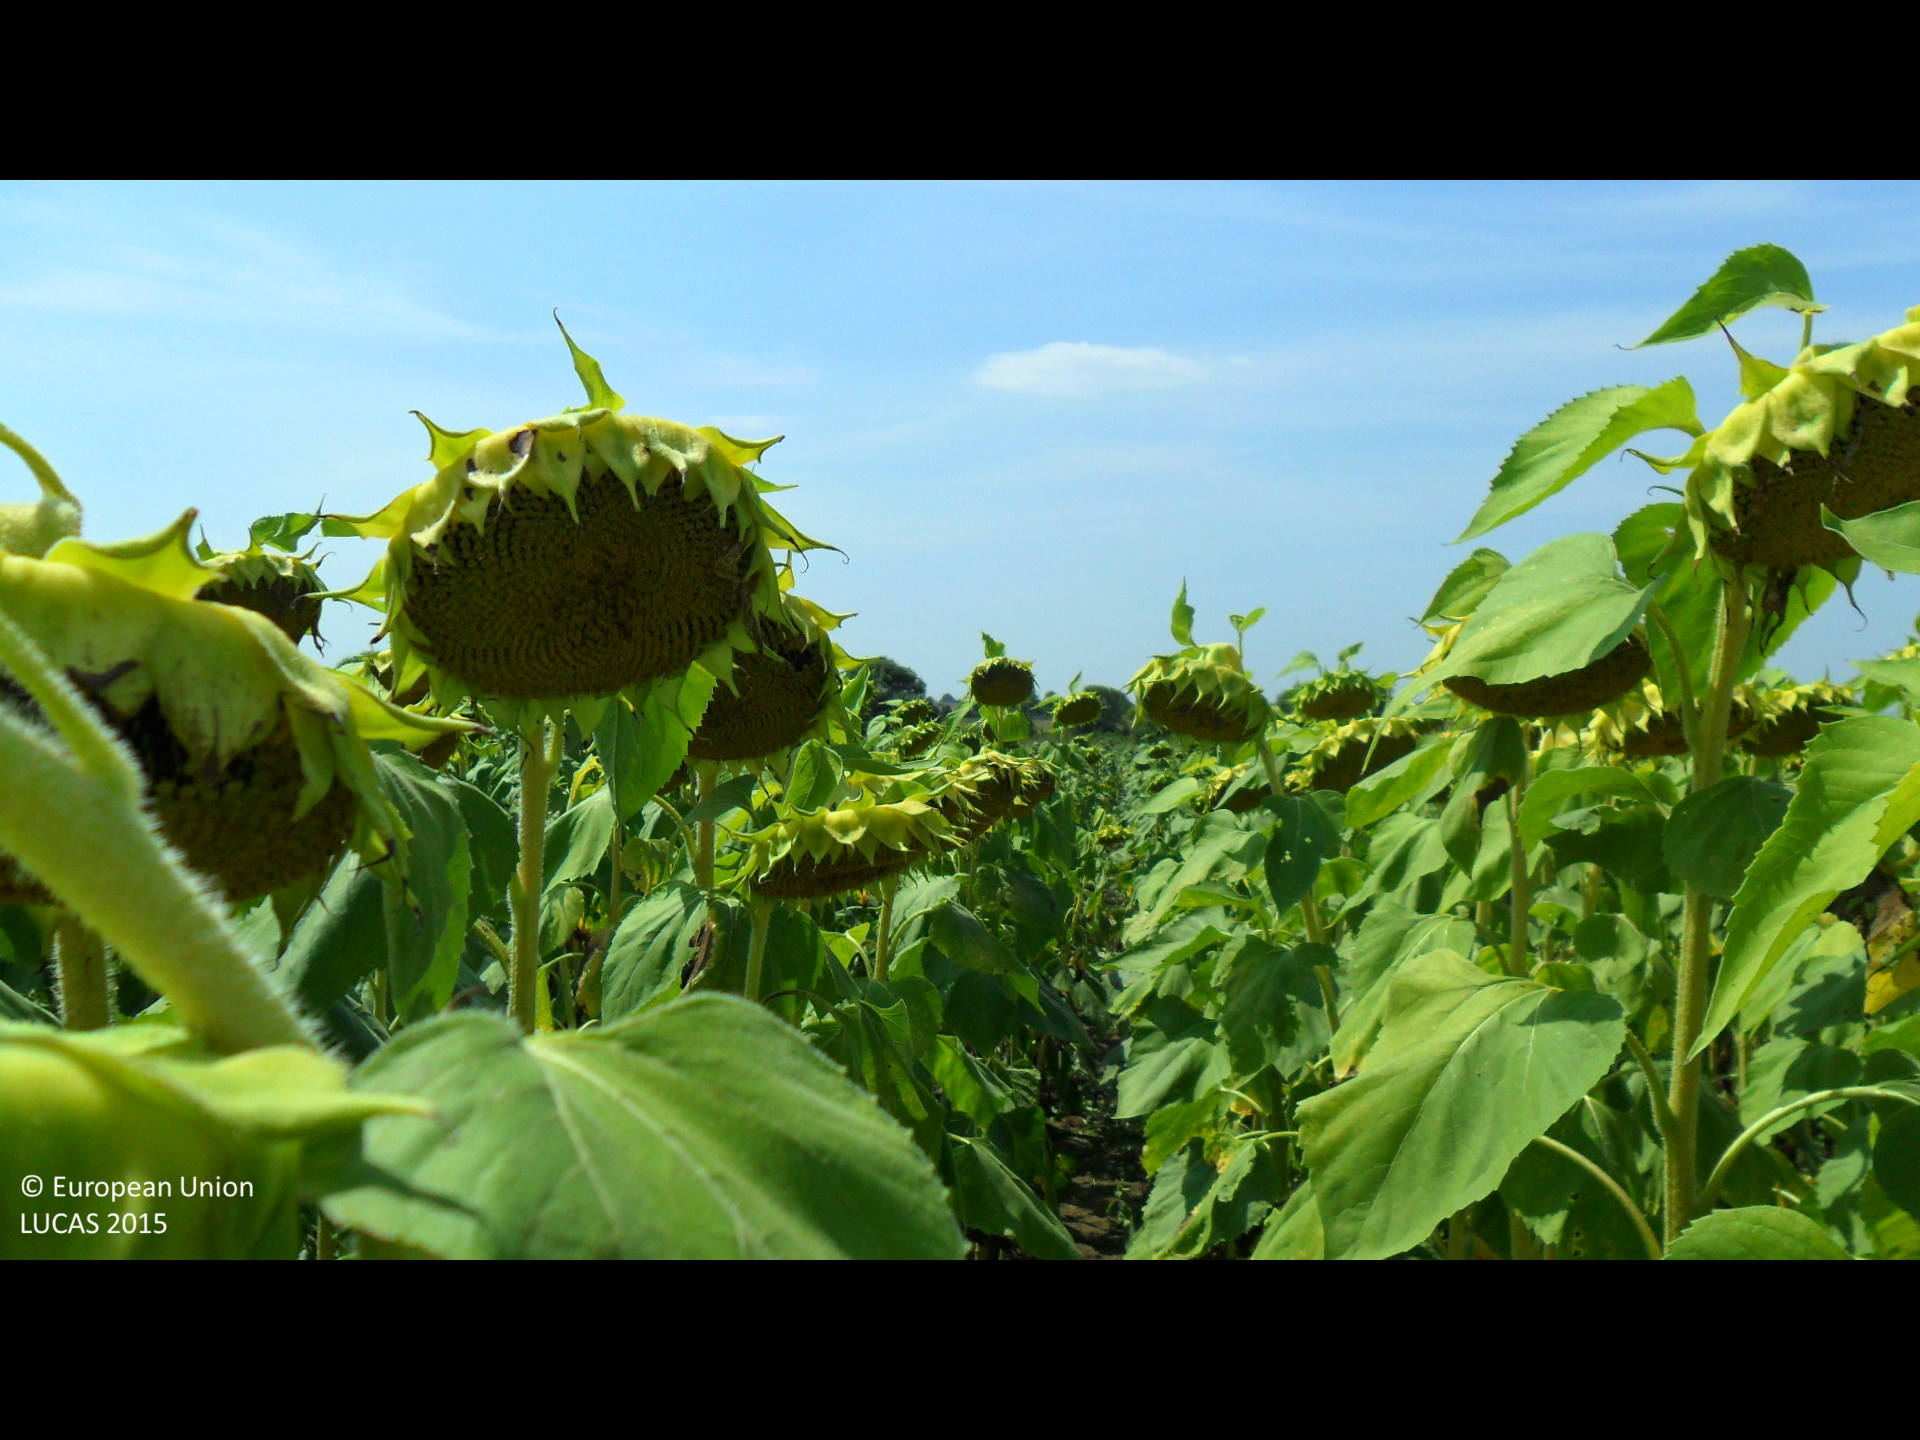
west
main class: Cropland
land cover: Sunflower
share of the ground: > 75 %
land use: Agriculture (excluding fallow land and kitchen gardens)
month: August
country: BG
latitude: 43.3284
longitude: 26.2902
